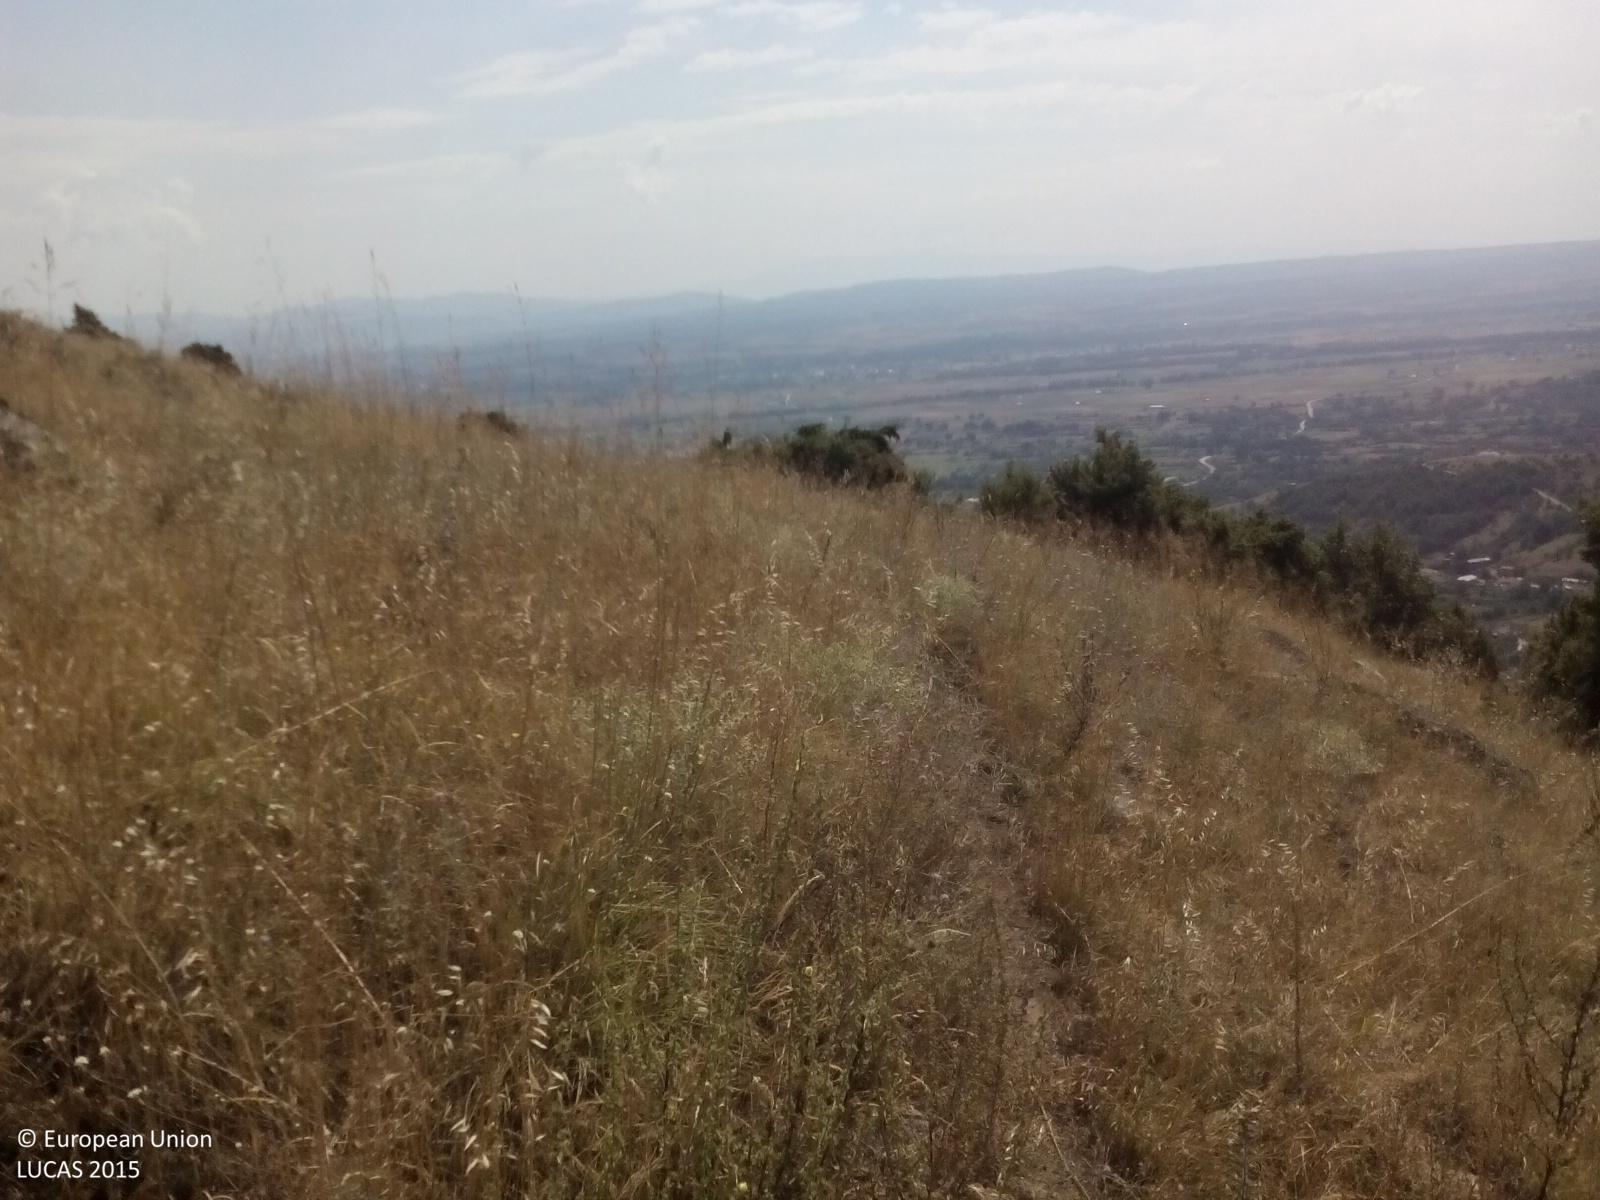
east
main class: Grassland
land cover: Grassland with sparse tree/shrub cover
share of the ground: > 75 %
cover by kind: herbaceous plants 85 %, shrubs 10 %, coniferous forest trees 5 %
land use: Semi-natural and natural areas not in use
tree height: < 5 m
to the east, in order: Grassland with sparse tree/shrub cover; Rock outcrops; Grassland with sparse tree/shrub cover; Broadleaved woodland; Grassland with sparse tree/shrub cover; Shrubland with sparse tree cover
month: August
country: GR
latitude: 40.7682
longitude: 21.4023
